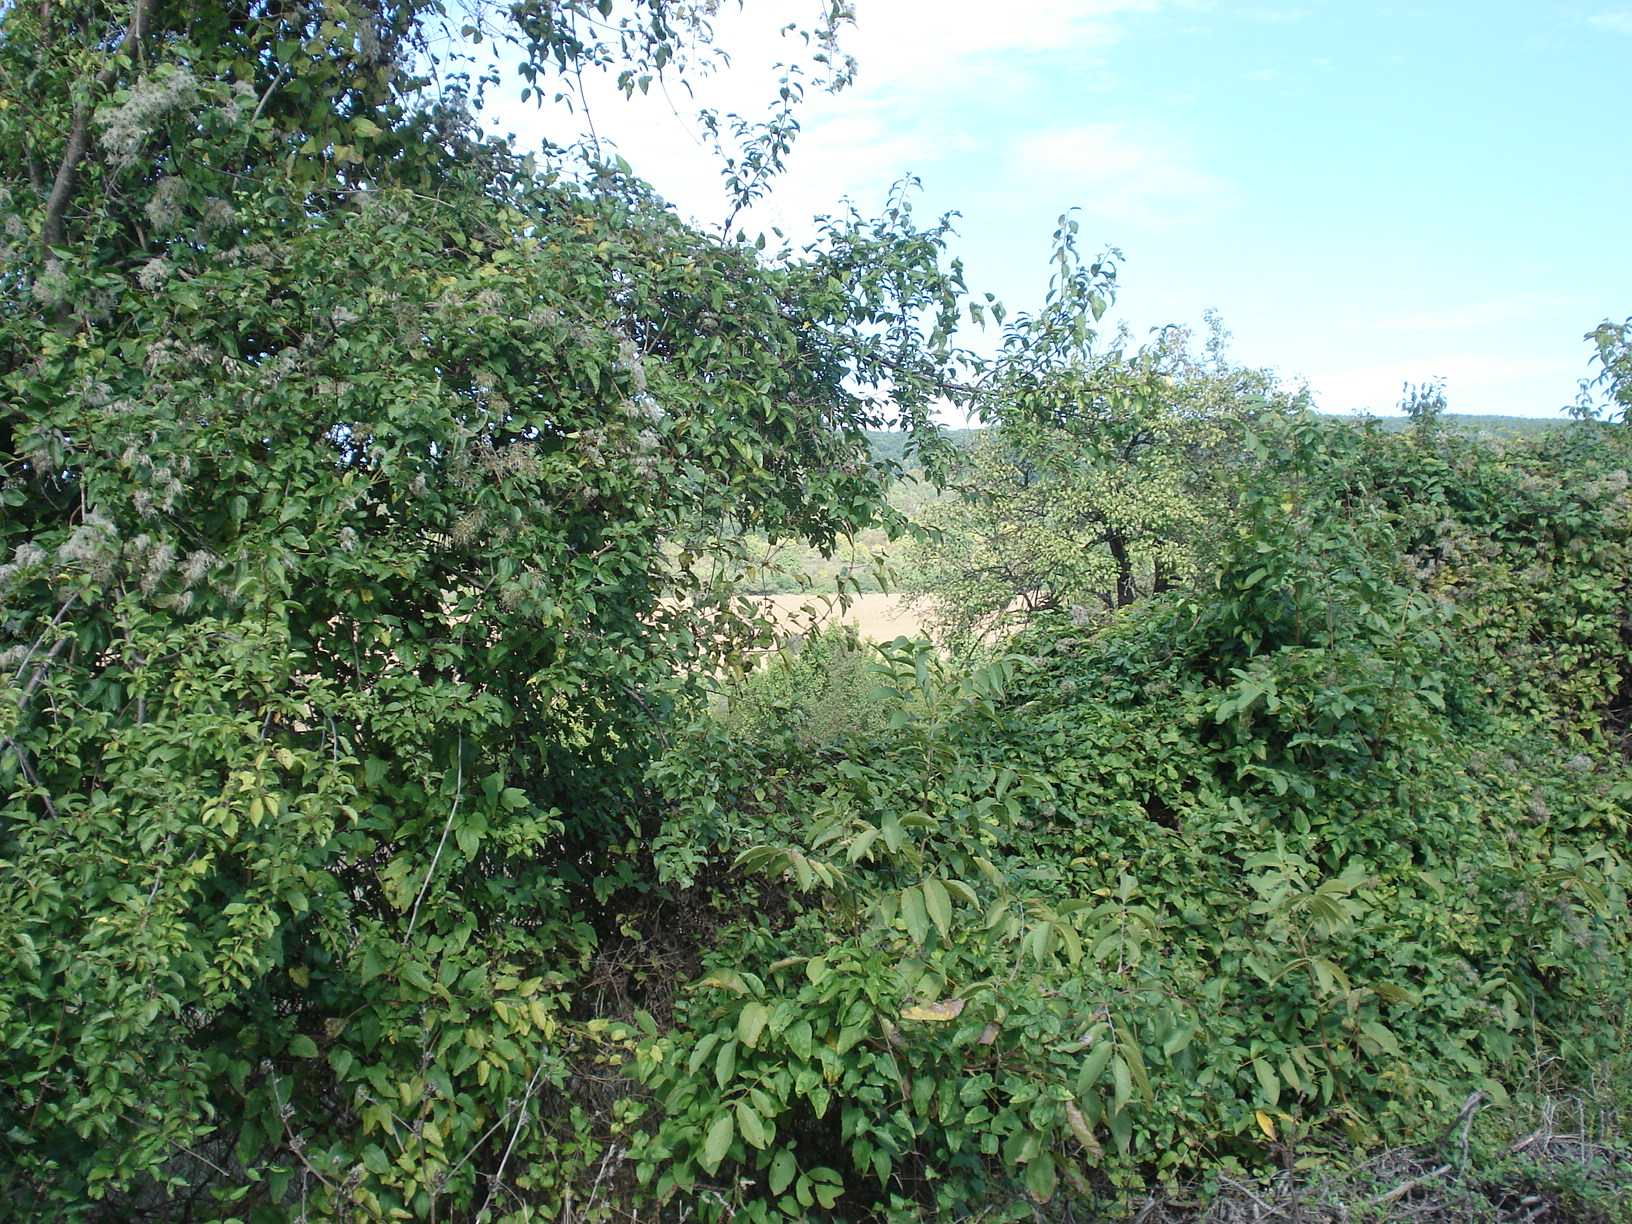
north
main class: Grassland
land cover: Grassland without tree/shrub cover
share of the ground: > 75 %
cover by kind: herbaceous plants 100 %
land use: Residential
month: October
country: BG
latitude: 43.1912
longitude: 25.9994
